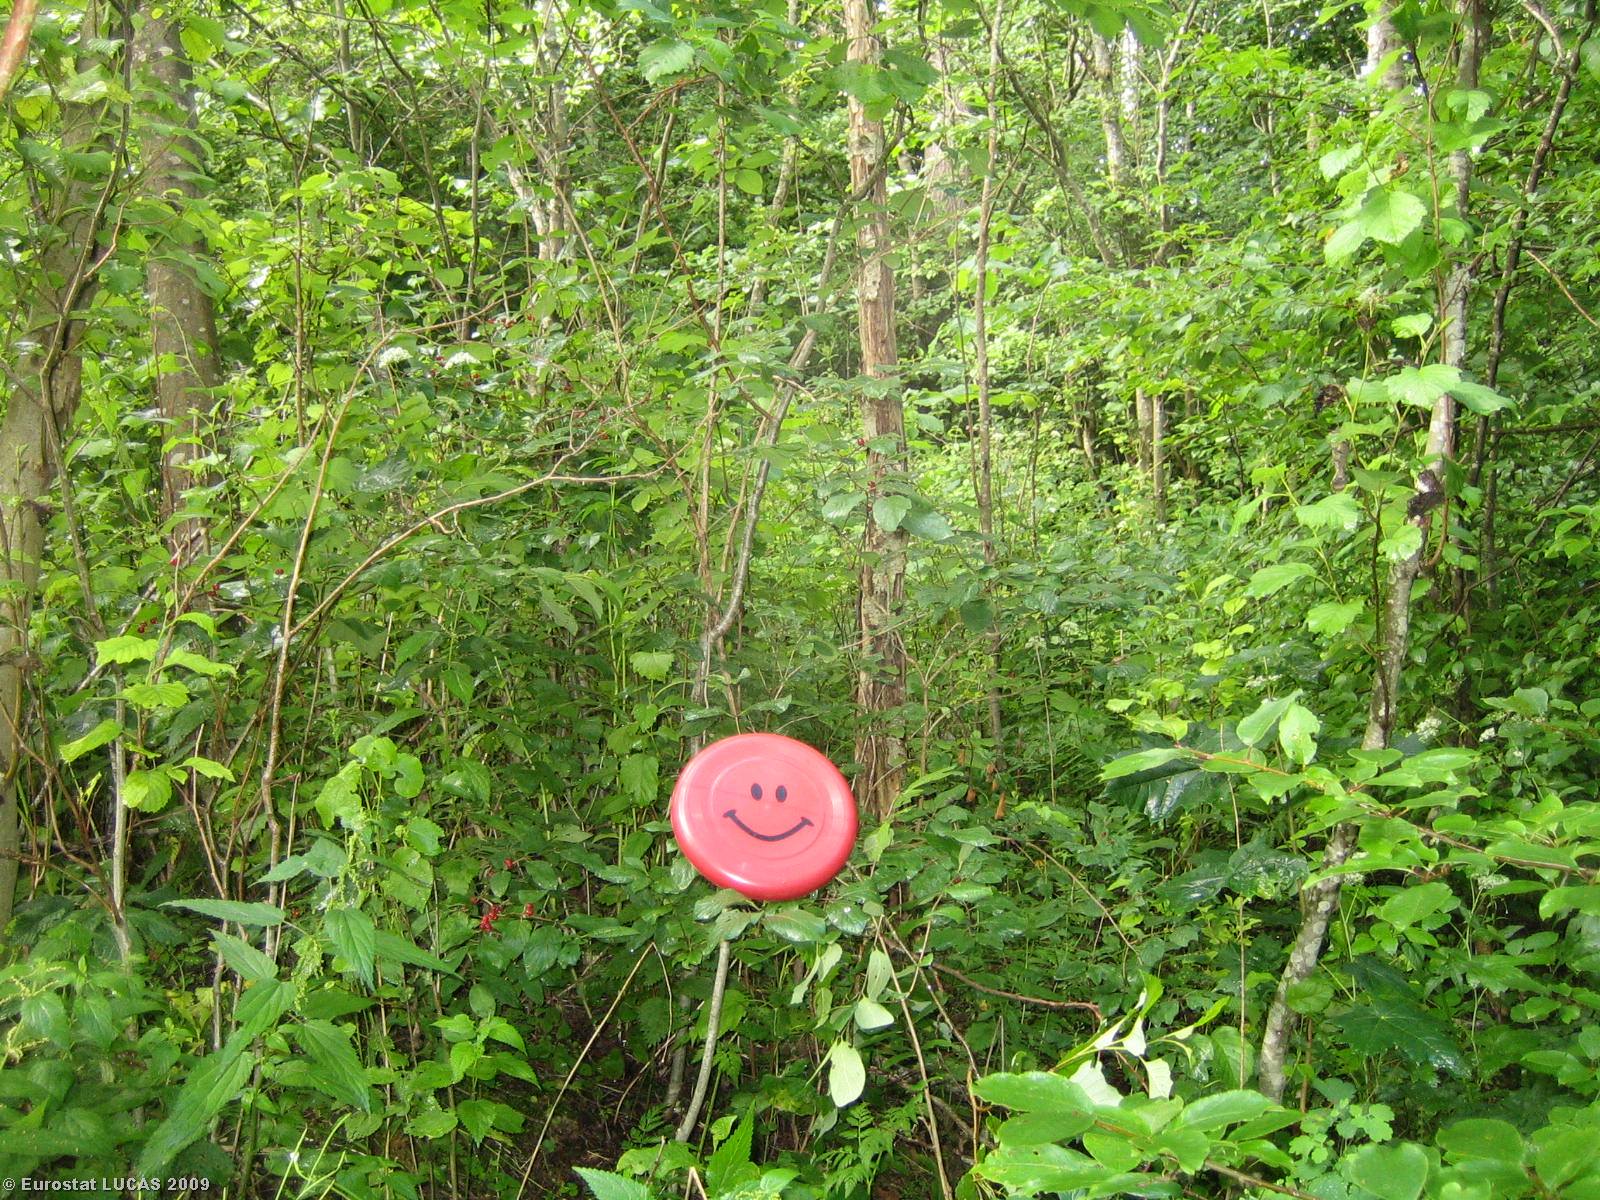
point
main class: Woodland
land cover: Mixed woodland
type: hemiboreal forest and nemoral coniferous forest and mixed broadleaved-coniferous forest
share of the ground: > 75 %
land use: Forestry
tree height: > 5 m
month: July
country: LT
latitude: 55.4619
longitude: 25.9033
